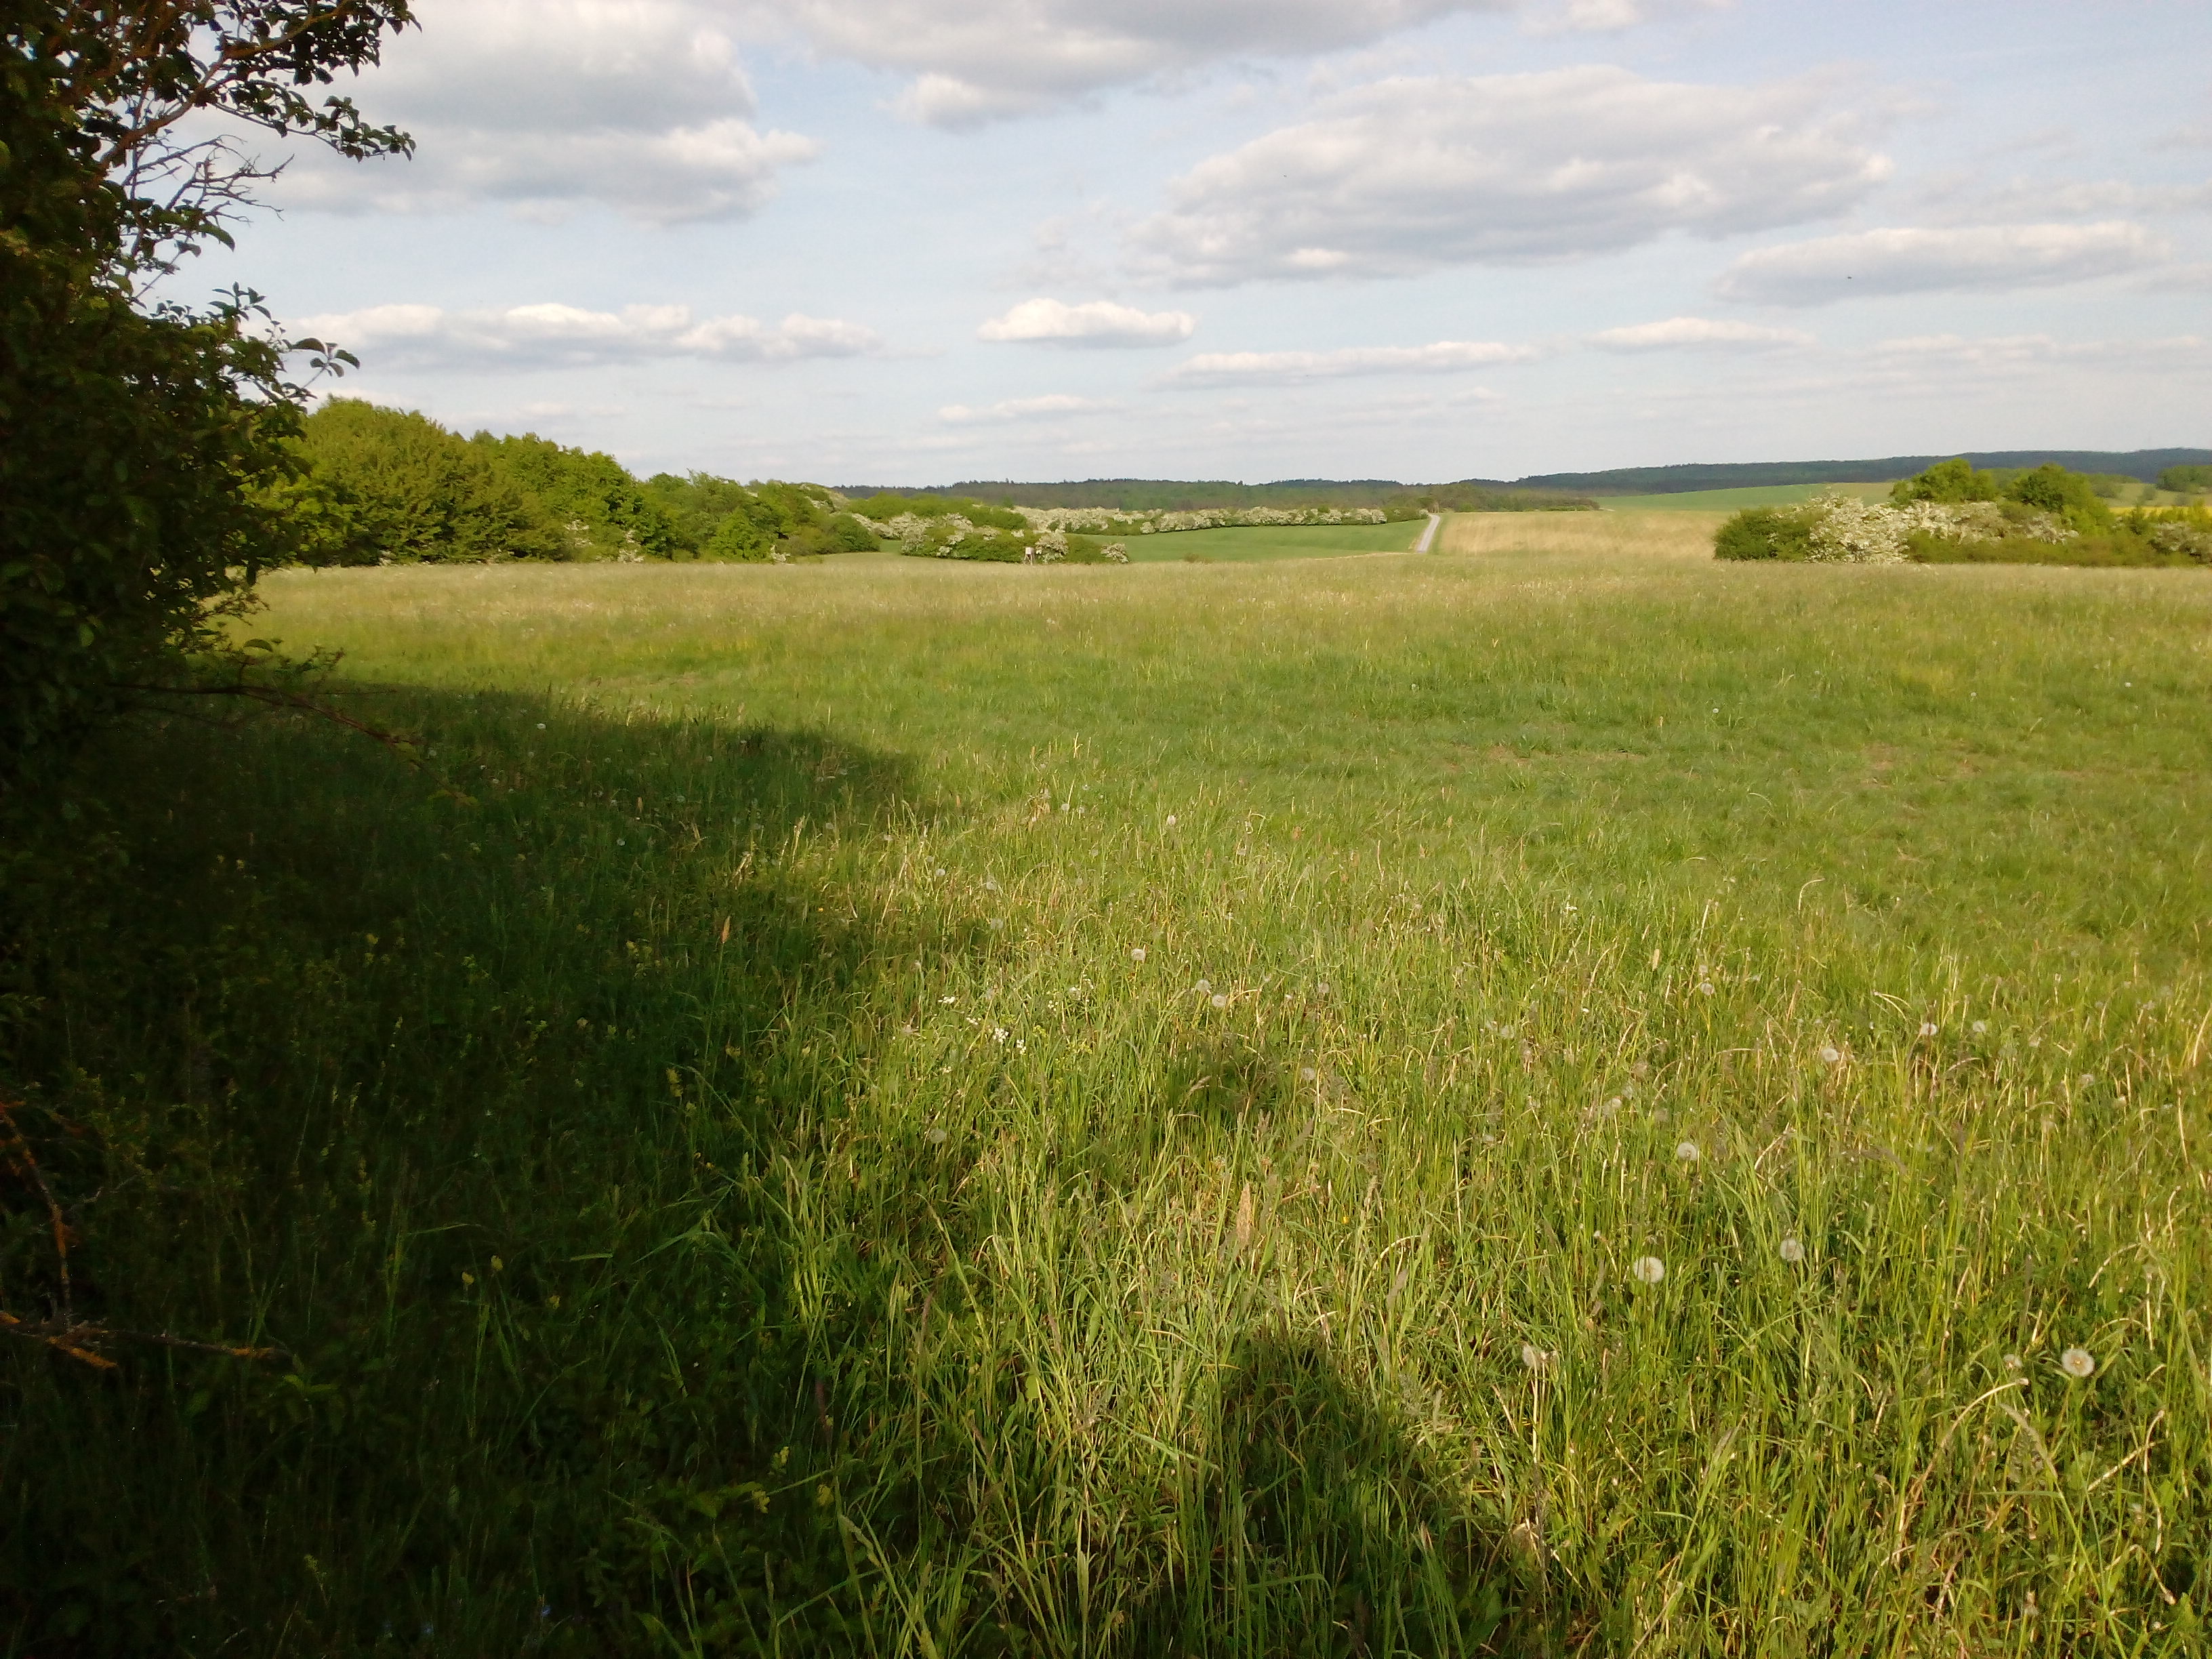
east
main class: Shrubland
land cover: Shrubland with sparse tree cover
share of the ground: > 75 %
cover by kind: shrubs 95 %, broadleaved forest trees 5 %
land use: Semi-natural and natural areas not in use
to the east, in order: Shrubland with sparse tree cover; Grassland without tree/shrub cover
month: May
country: DE
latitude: 50.3970
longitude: 10.8297
